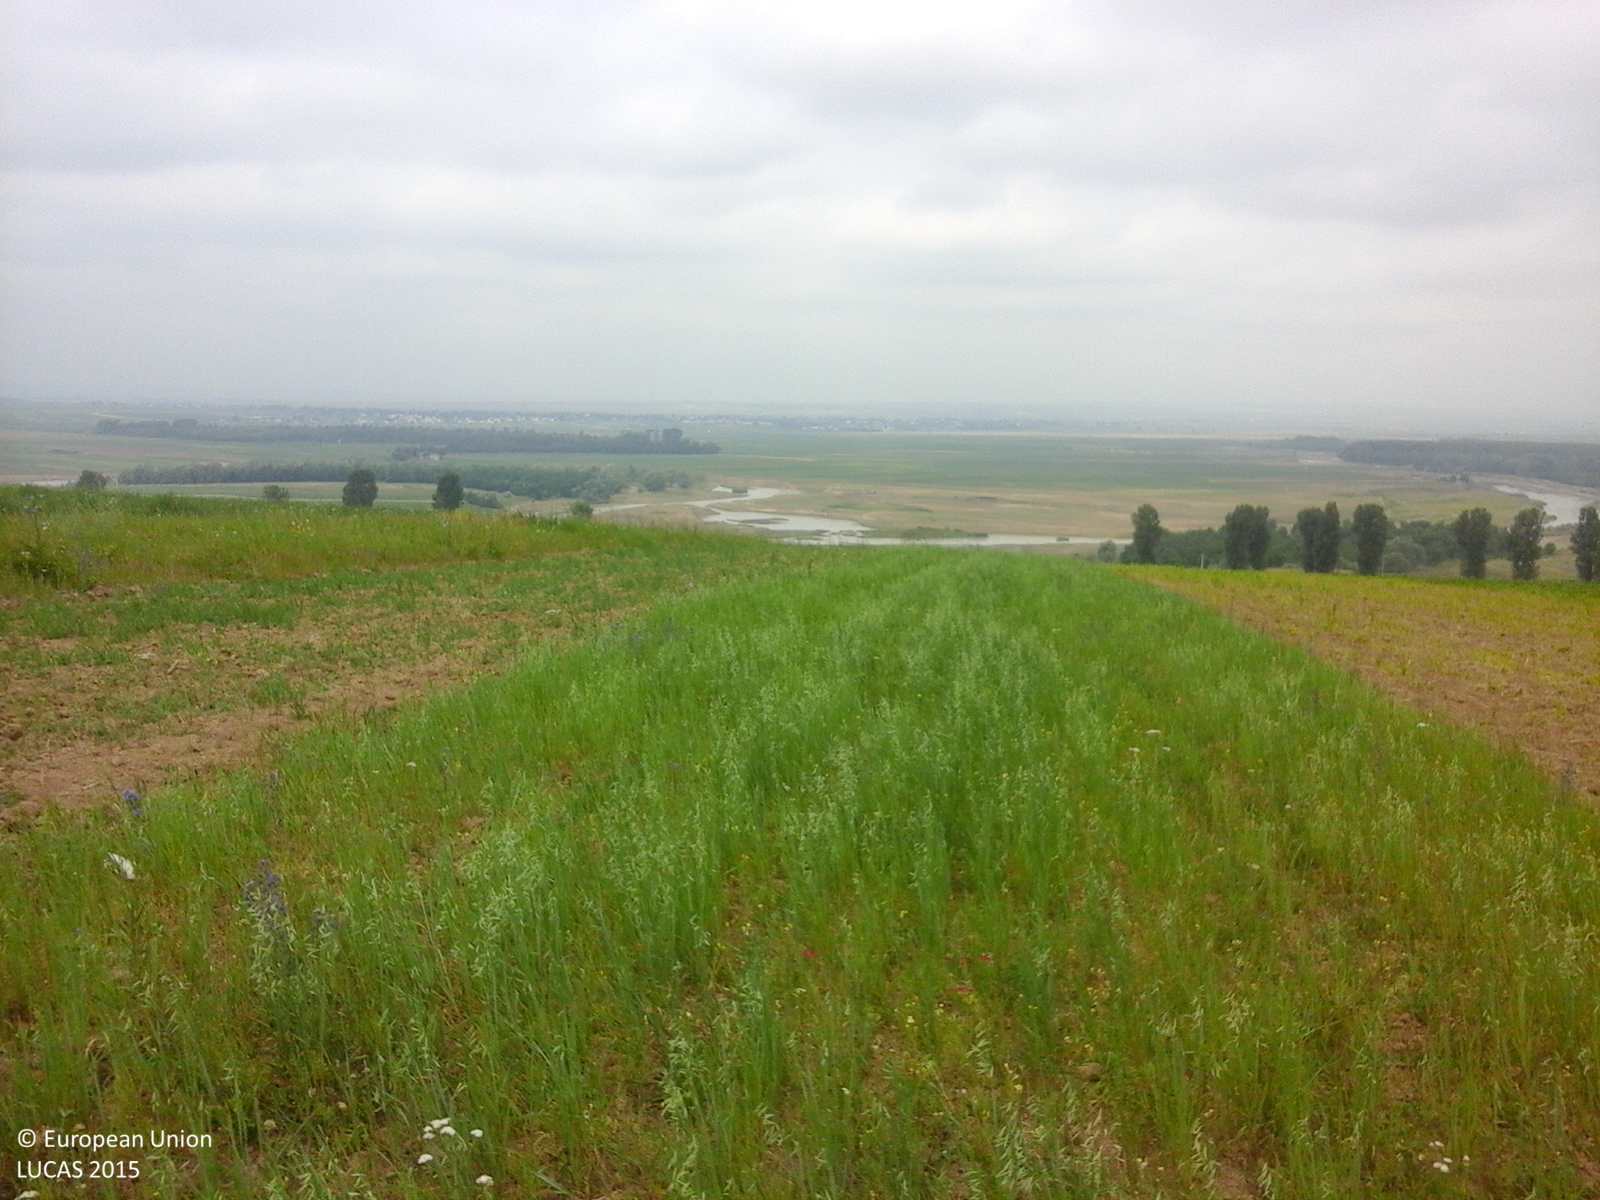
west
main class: Cropland
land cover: Oats
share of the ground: > 75 %
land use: Agriculture (excluding fallow land and kitchen gardens)
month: June
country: RO
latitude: 47.6396
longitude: 26.5564
